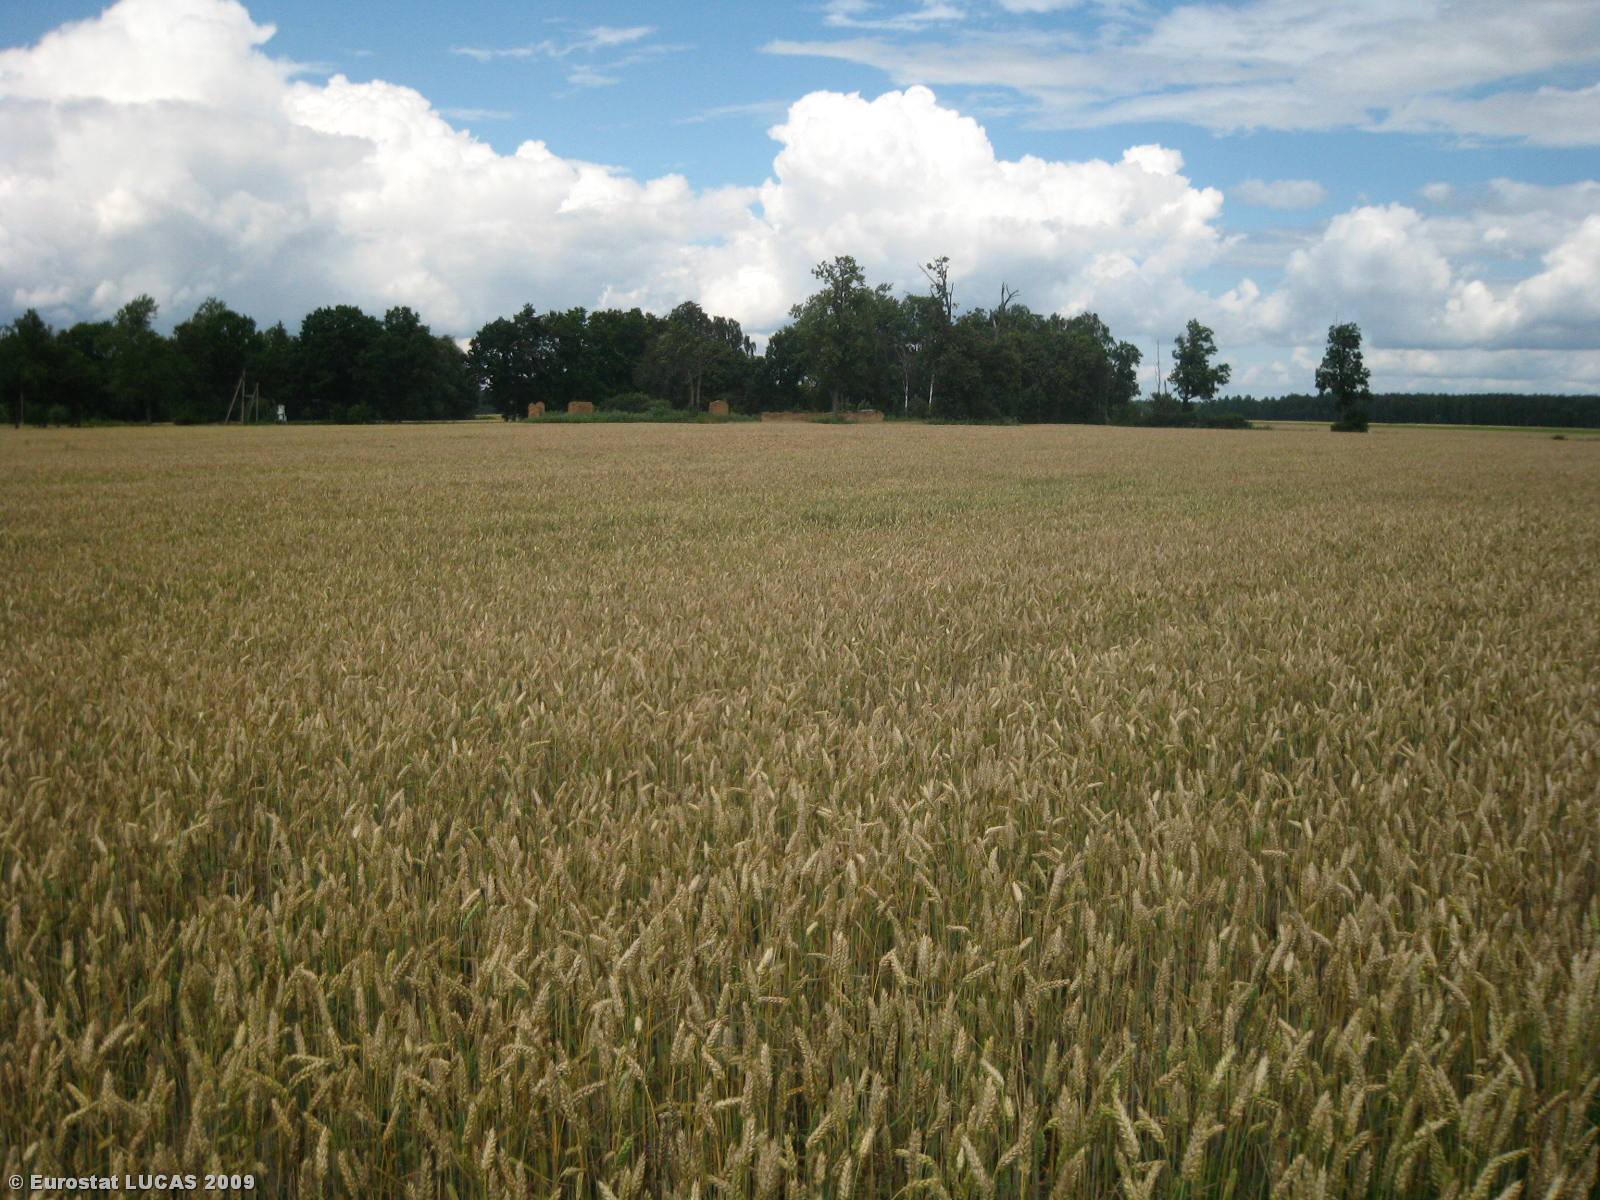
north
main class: Cropland
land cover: Common wheat
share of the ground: > 75 %
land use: Agriculture (excluding fallow land and kitchen gardens)
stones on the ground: < 10 %
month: July
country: LT
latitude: 55.6322
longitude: 24.0194
